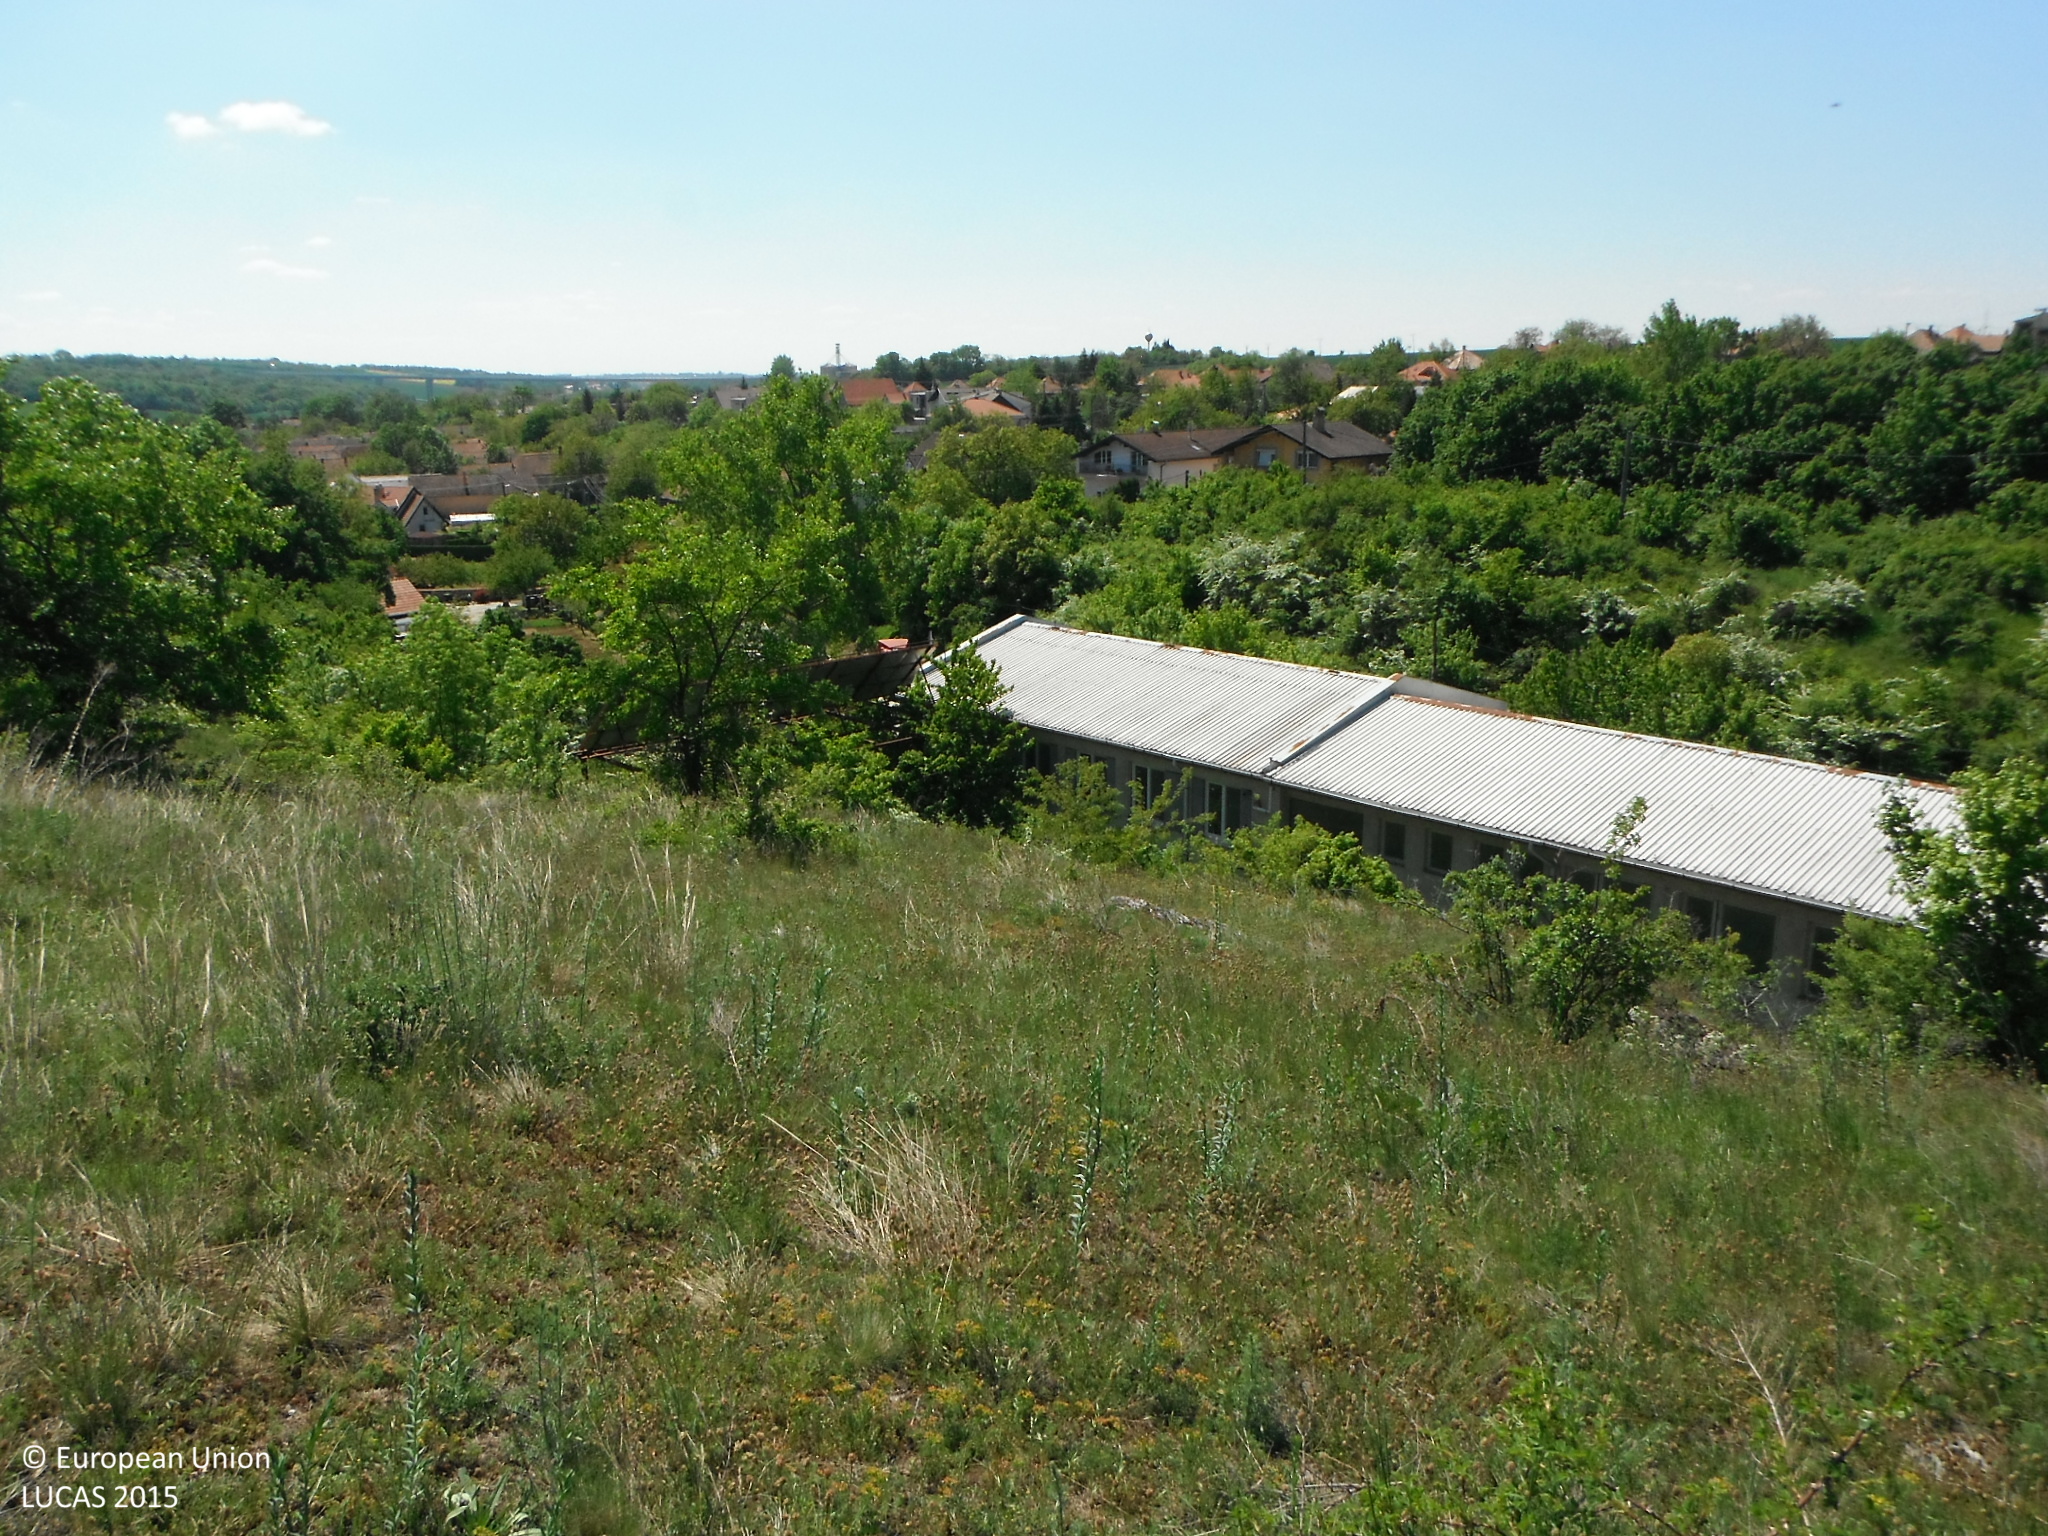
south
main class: Grassland
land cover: Spontaneously vegetated surfaces
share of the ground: > 75 %
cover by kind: herbaceous plants 95 %, shrubs 5 %
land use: Semi-natural and natural areas not in use
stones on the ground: 10 - 25 %
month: May
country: SK
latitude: 48.3355
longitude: 18.1758
